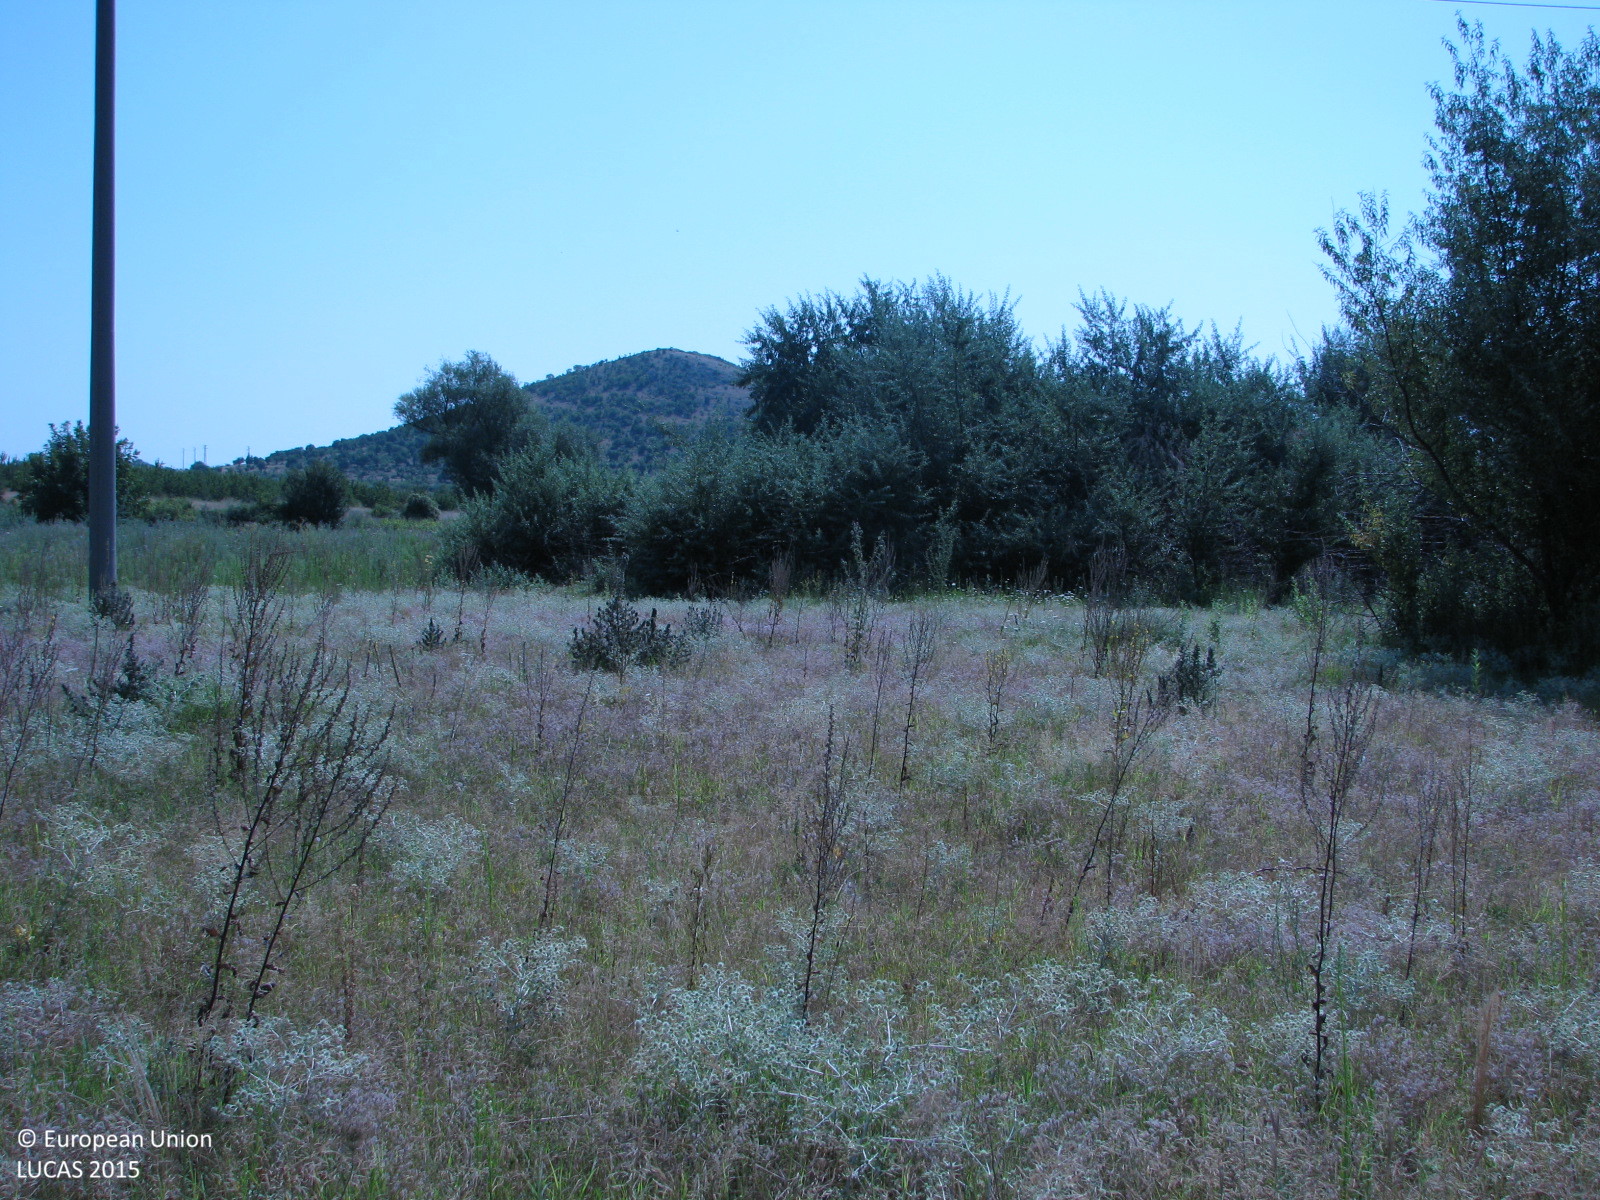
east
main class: Grassland
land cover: Grassland with sparse tree/shrub cover
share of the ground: > 75 %
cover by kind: herbaceous plants 90 %, broadleaved forest trees 5 %, shrubs 5 %
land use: Abandoned areas
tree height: < 5 m
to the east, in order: Grassland with sparse tree/shrub cover; Electric lines; Broadleaved woodland; Inland fresh running water; Grassland without tree/shrub cover; Tracks; Grassland with sparse tree/shrub cover; Fences; Cherry fruit
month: July
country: BG
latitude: 42.6389
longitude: 26.1225
